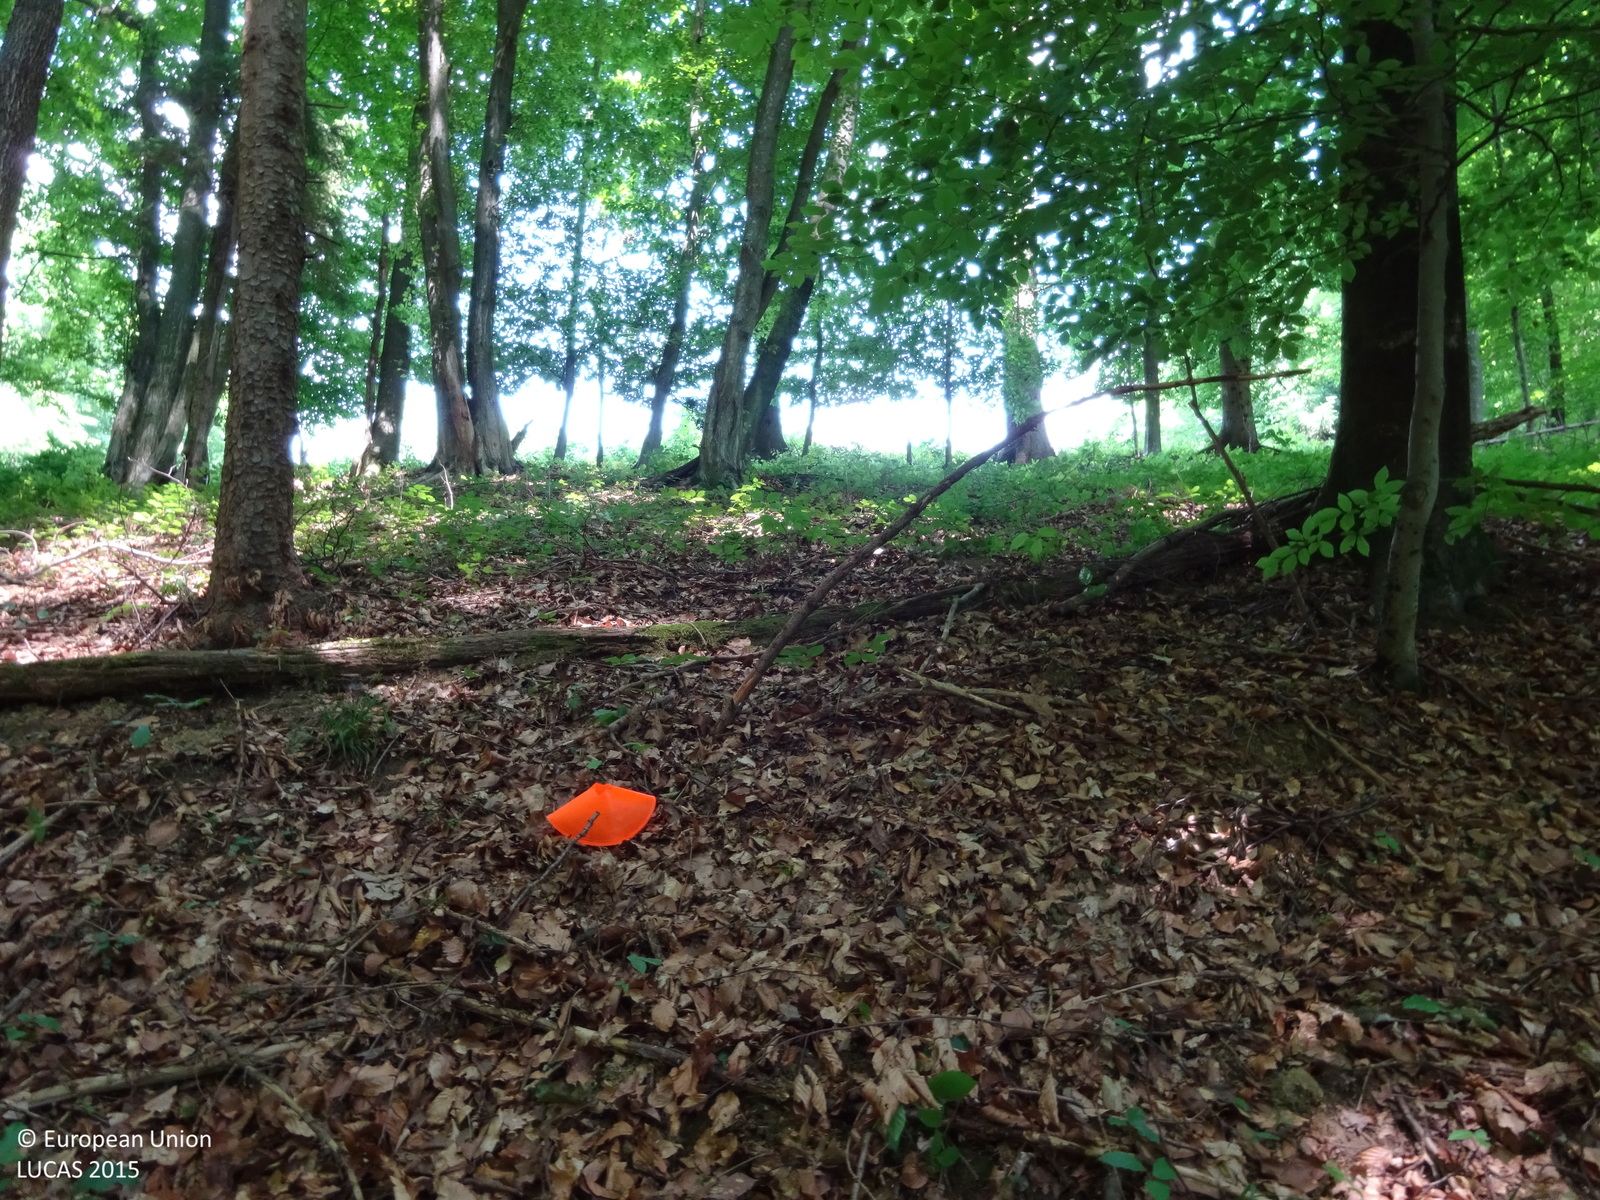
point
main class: Woodland
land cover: Broadleaved woodland
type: mountainous beech forest
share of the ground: > 75 %
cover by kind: broadleaved forest trees 95 %, coniferous forest trees 5 %
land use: Forestry
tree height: > 5 m
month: July
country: AT
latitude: 46.9006
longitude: 16.0787
